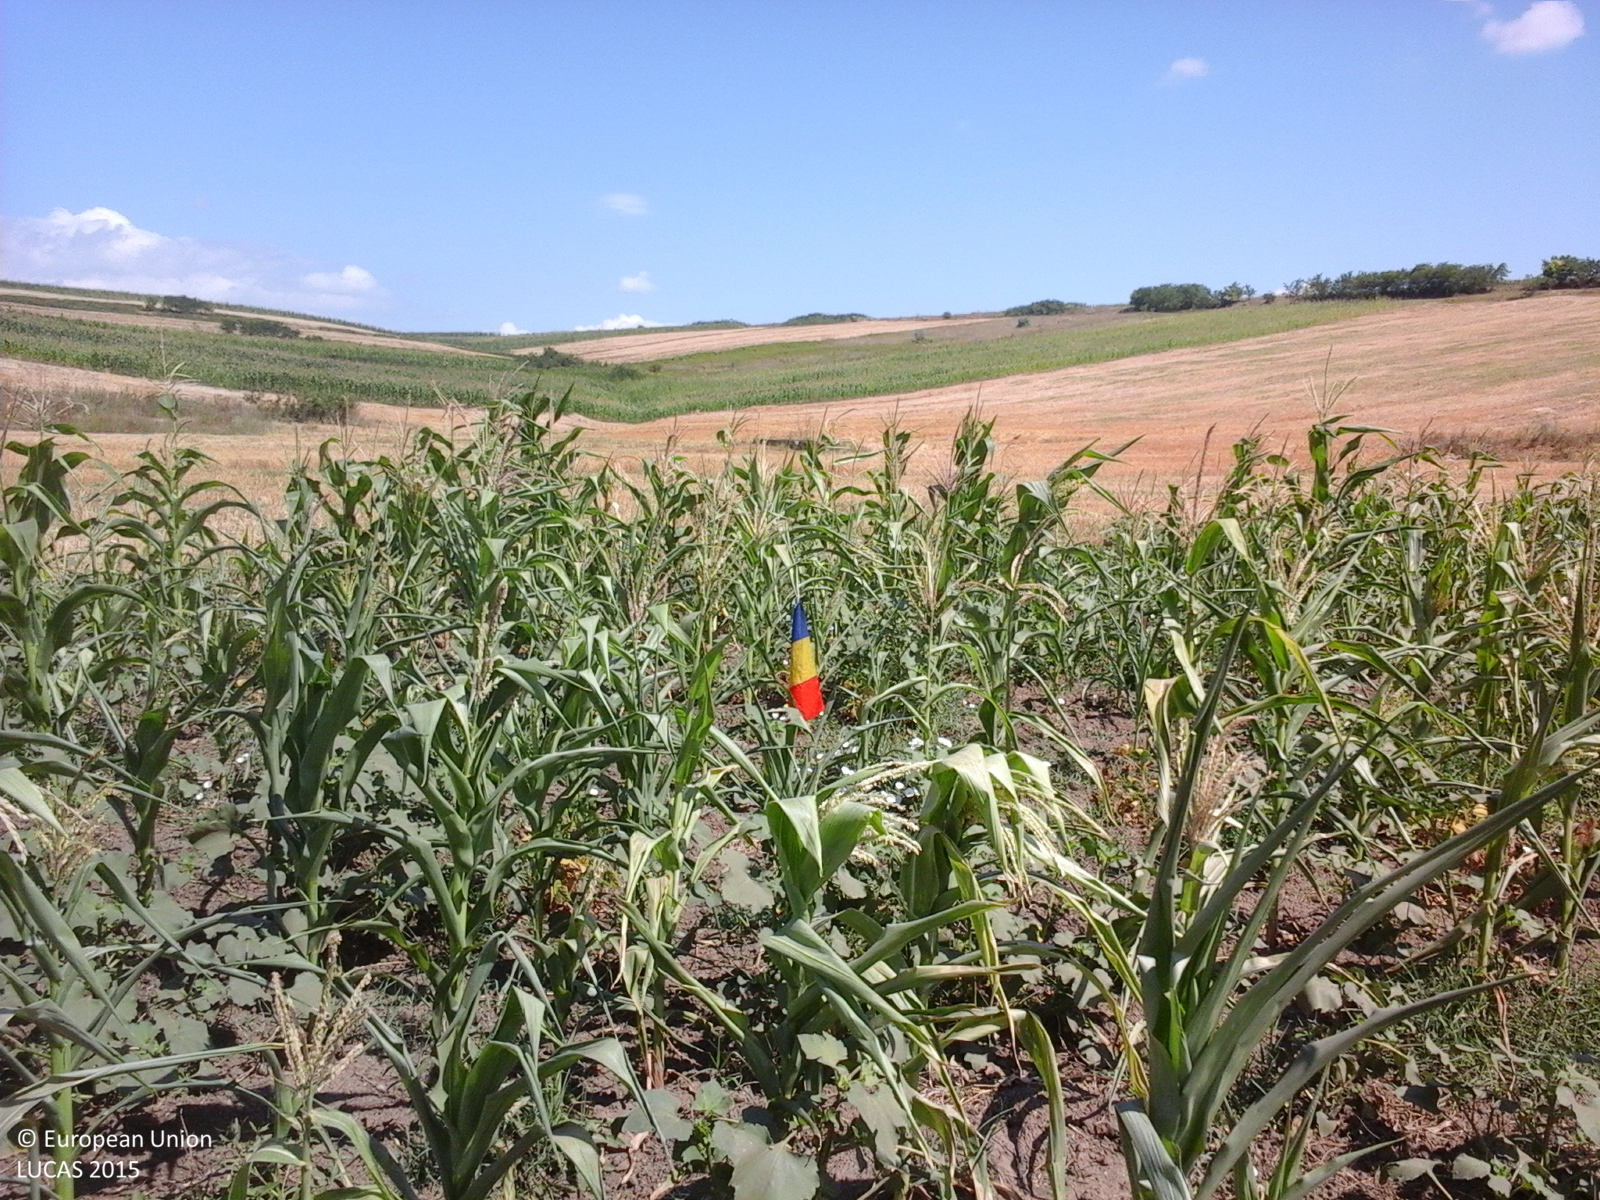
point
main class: Cropland
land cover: Maize
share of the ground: > 75 %
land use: Agriculture (excluding fallow land and kitchen gardens)
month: July
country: RO
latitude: 46.3529
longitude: 27.9129
